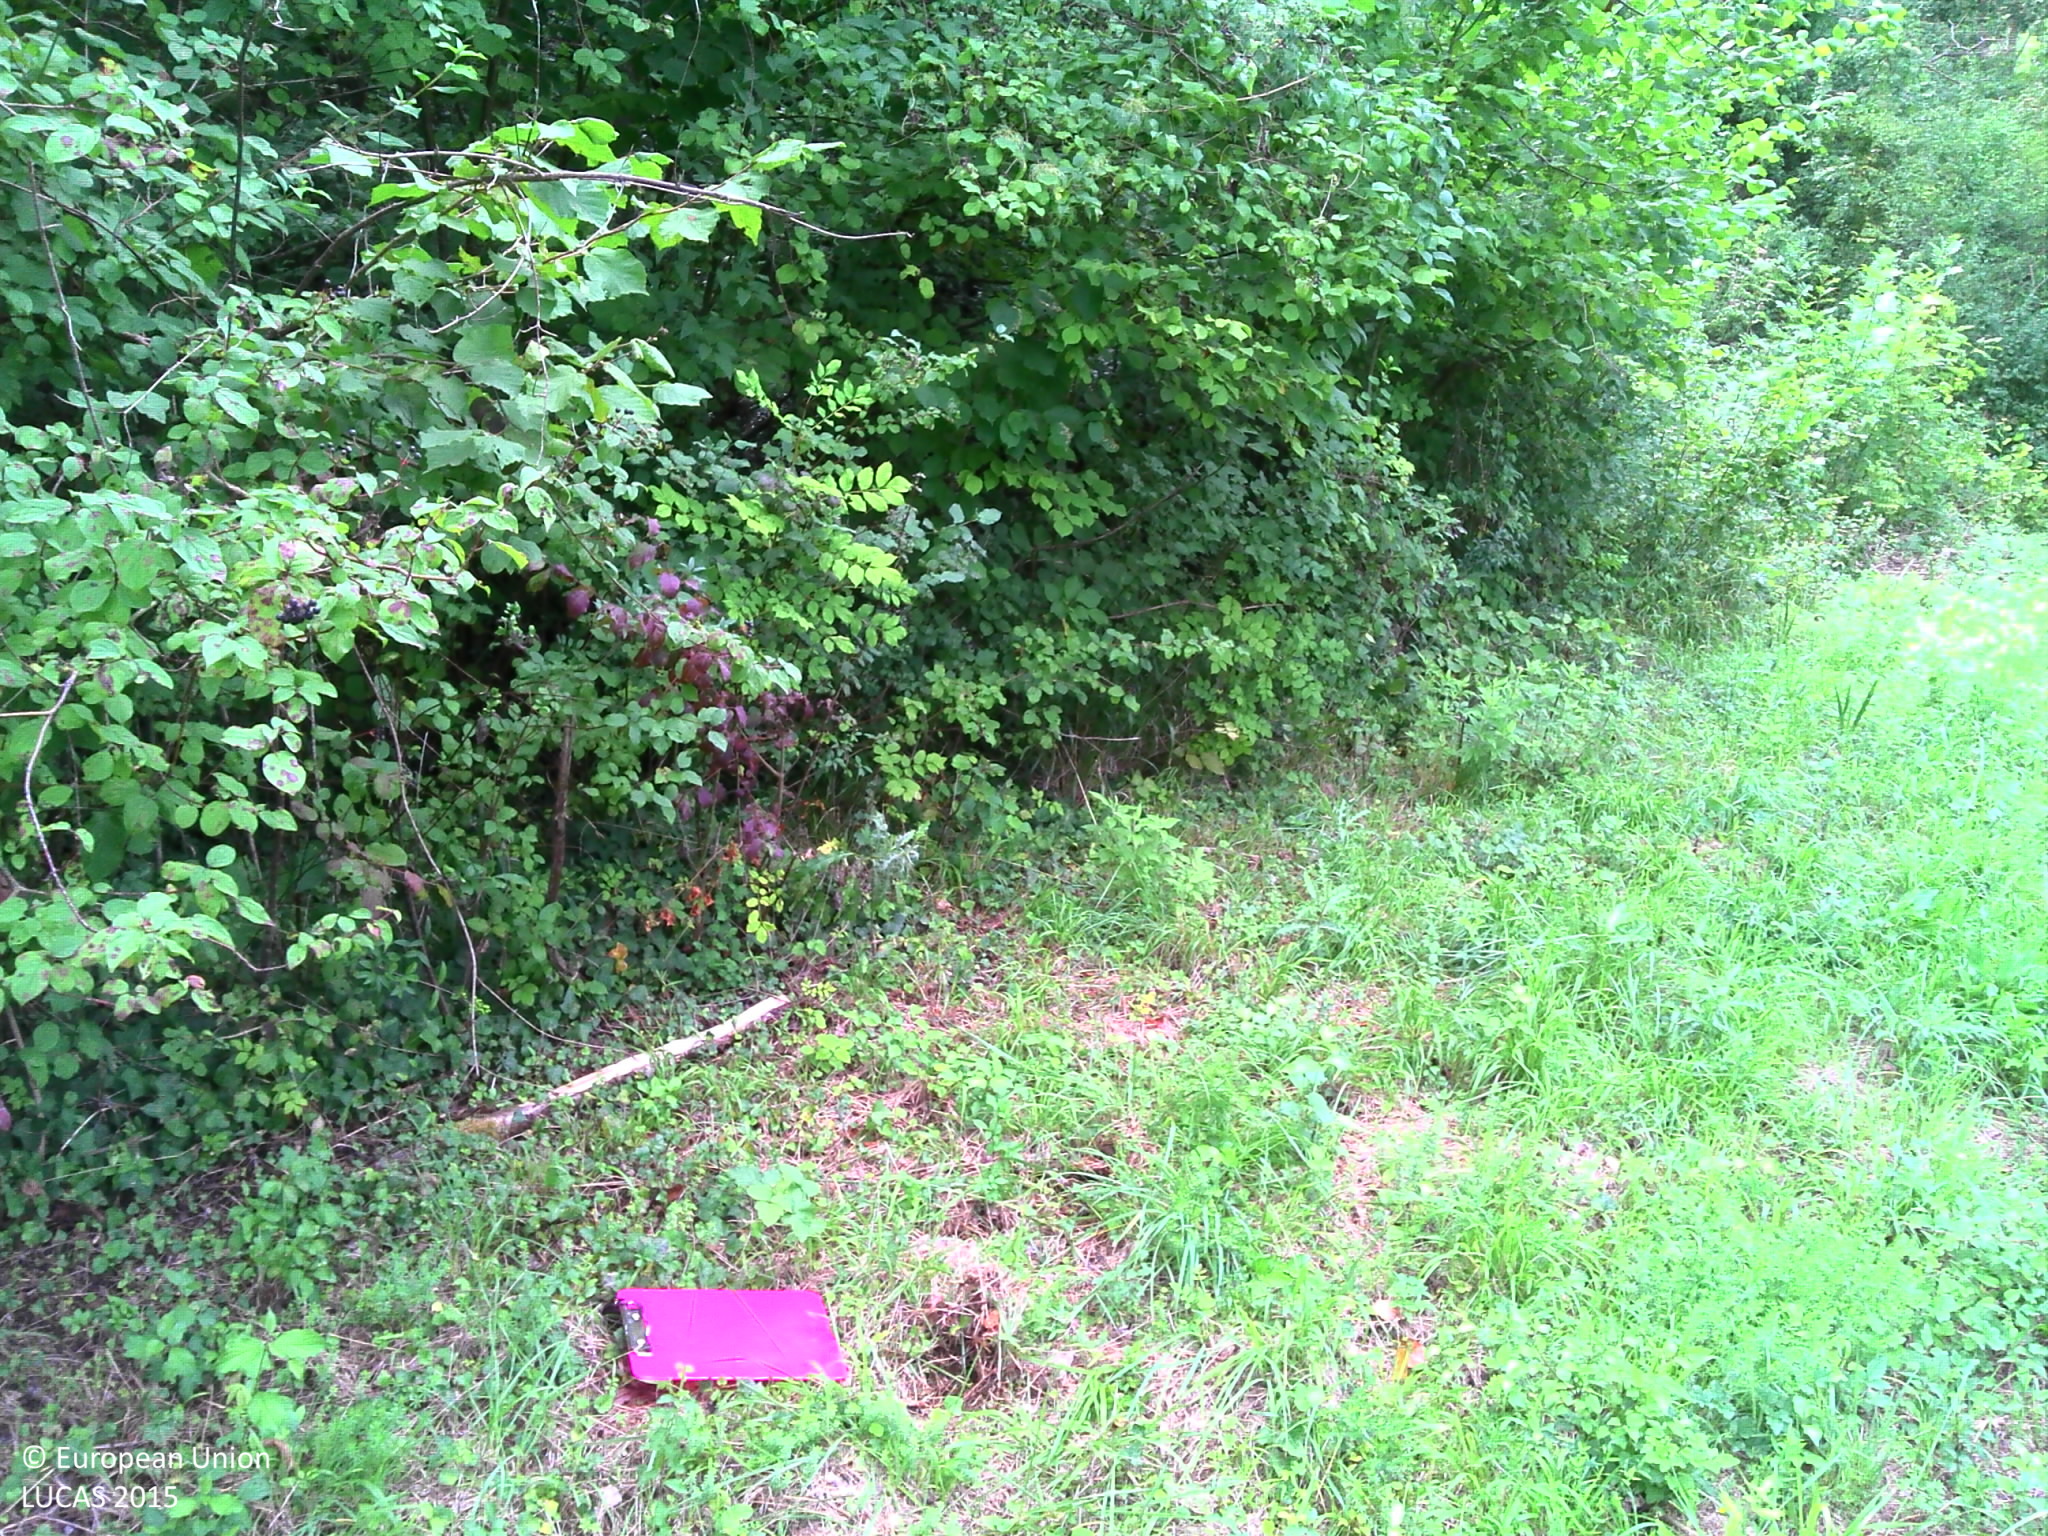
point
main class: Grassland
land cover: Grassland without tree/shrub cover
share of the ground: > 75 %
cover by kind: herbaceous plants 100 %
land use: Agriculture (excluding fallow land and kitchen gardens)
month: August
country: FR
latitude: 43.0443
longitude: 1.7702
